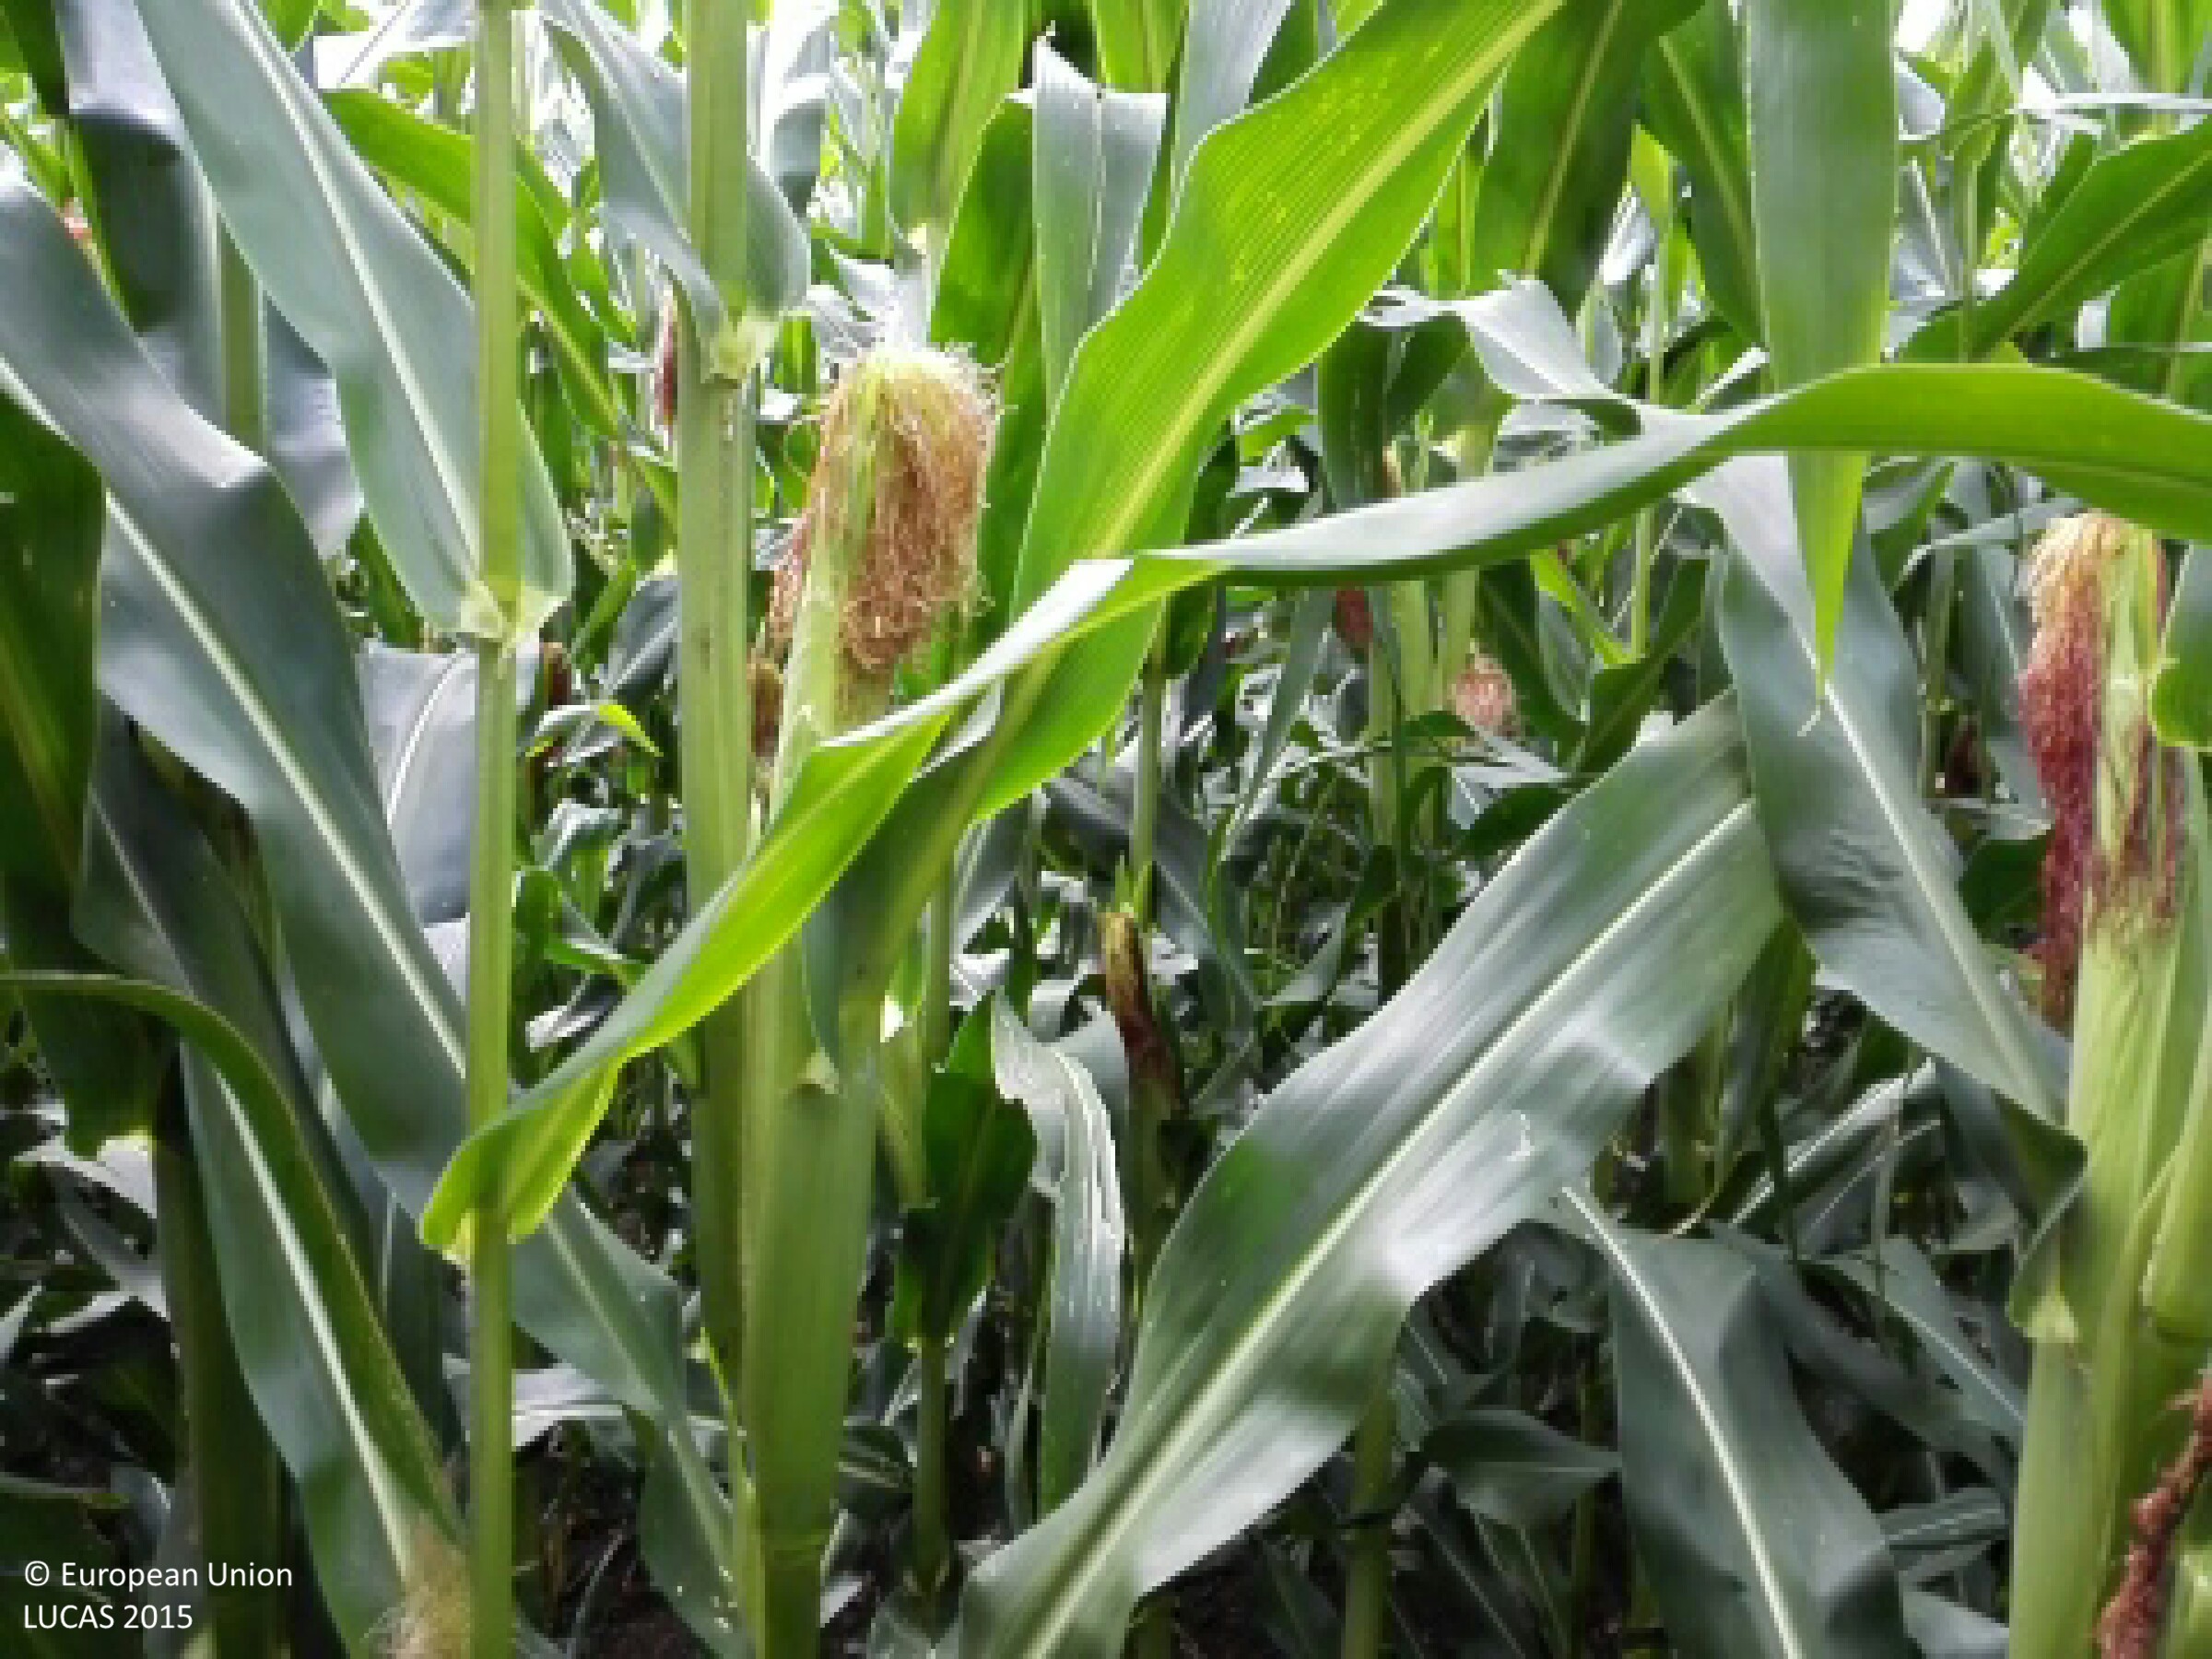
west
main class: Cropland
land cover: Maize
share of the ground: > 75 %
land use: Agriculture (excluding fallow land and kitchen gardens)
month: July
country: HU
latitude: 47.5596
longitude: 21.3781
